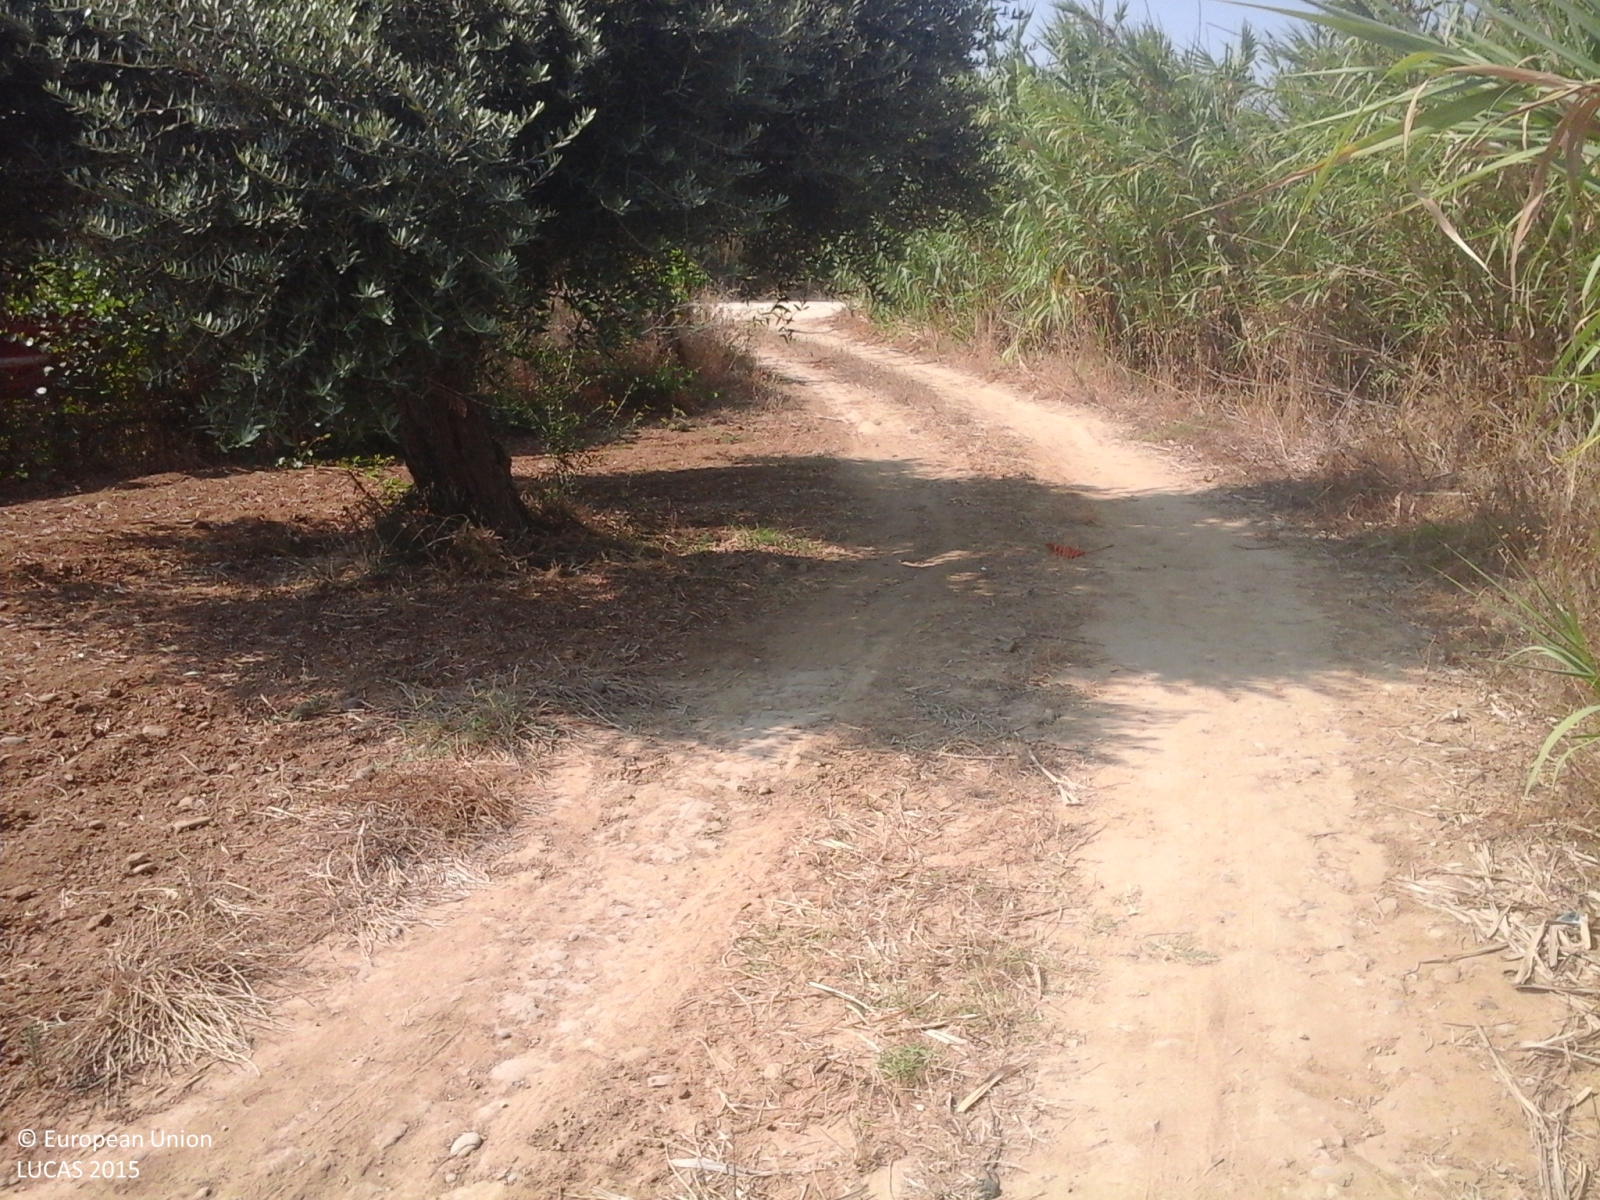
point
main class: Grassland
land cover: Grassland with sparse tree/shrub cover
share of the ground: > 75 %
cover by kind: herbaceous plants 95 %, broadleaved forest trees 5 %
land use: Agriculture (excluding fallow land and kitchen gardens)
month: July
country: IT
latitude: 37.0474
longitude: 14.3619
